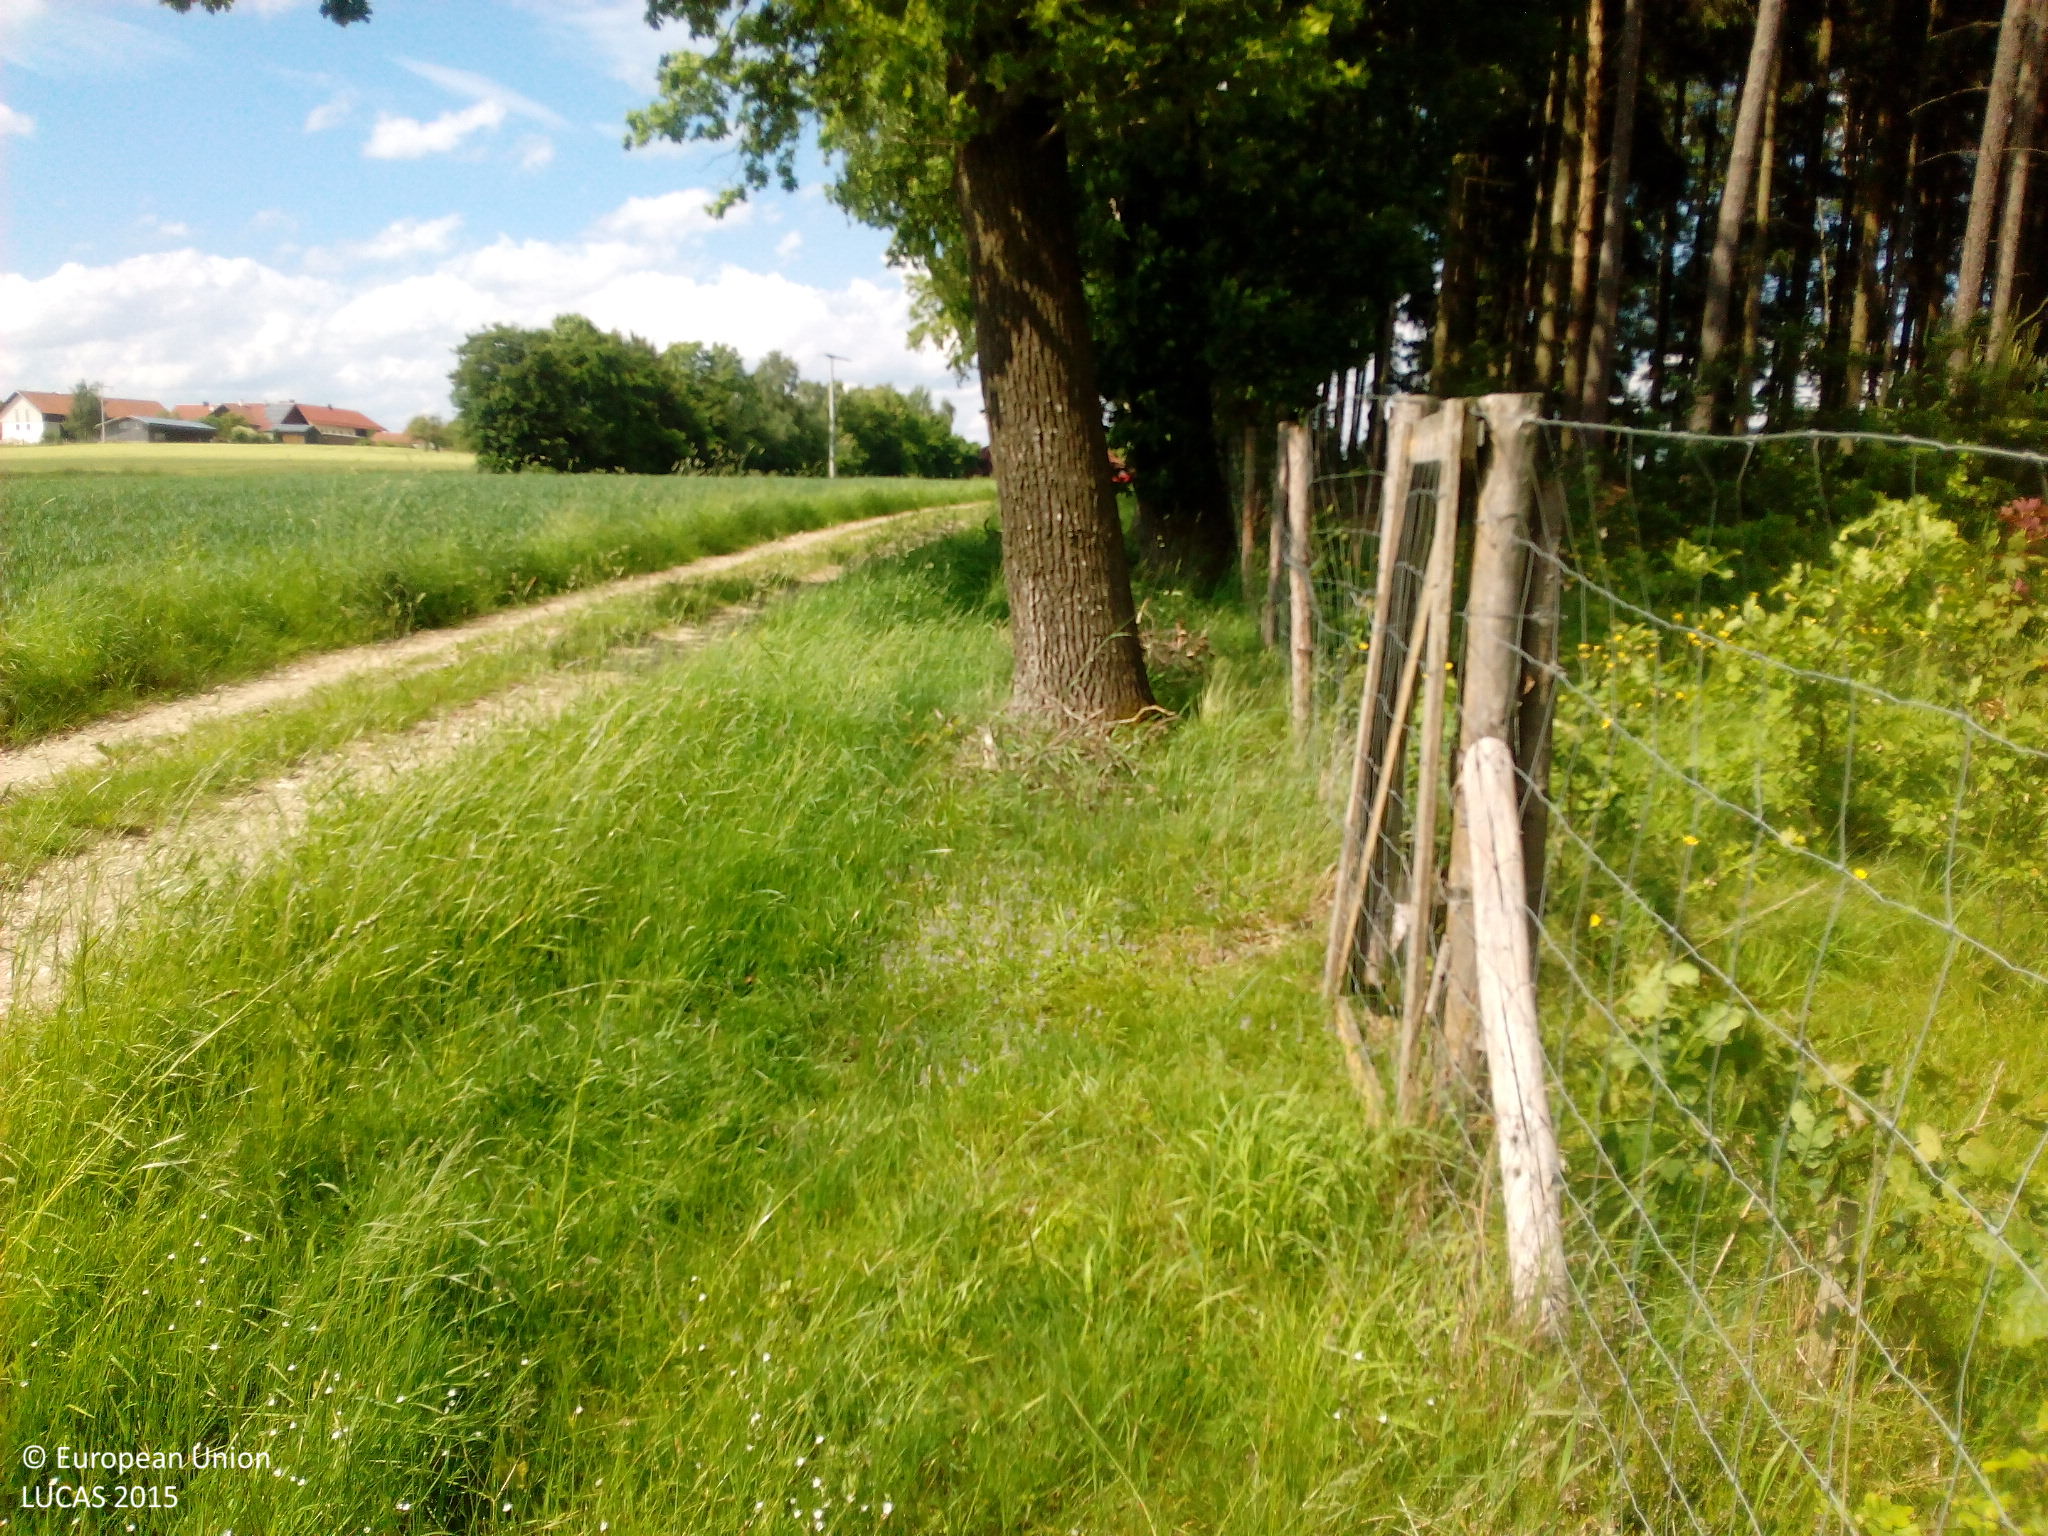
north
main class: Woodland
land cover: Broadleaved woodland
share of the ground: 25 - 50 %
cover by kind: herbaceous plants 55 %, broadleaved forest trees 40 %, coniferous forest trees 5 %
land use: Forestry
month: June
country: DE
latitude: 48.5227
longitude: 12.3415
